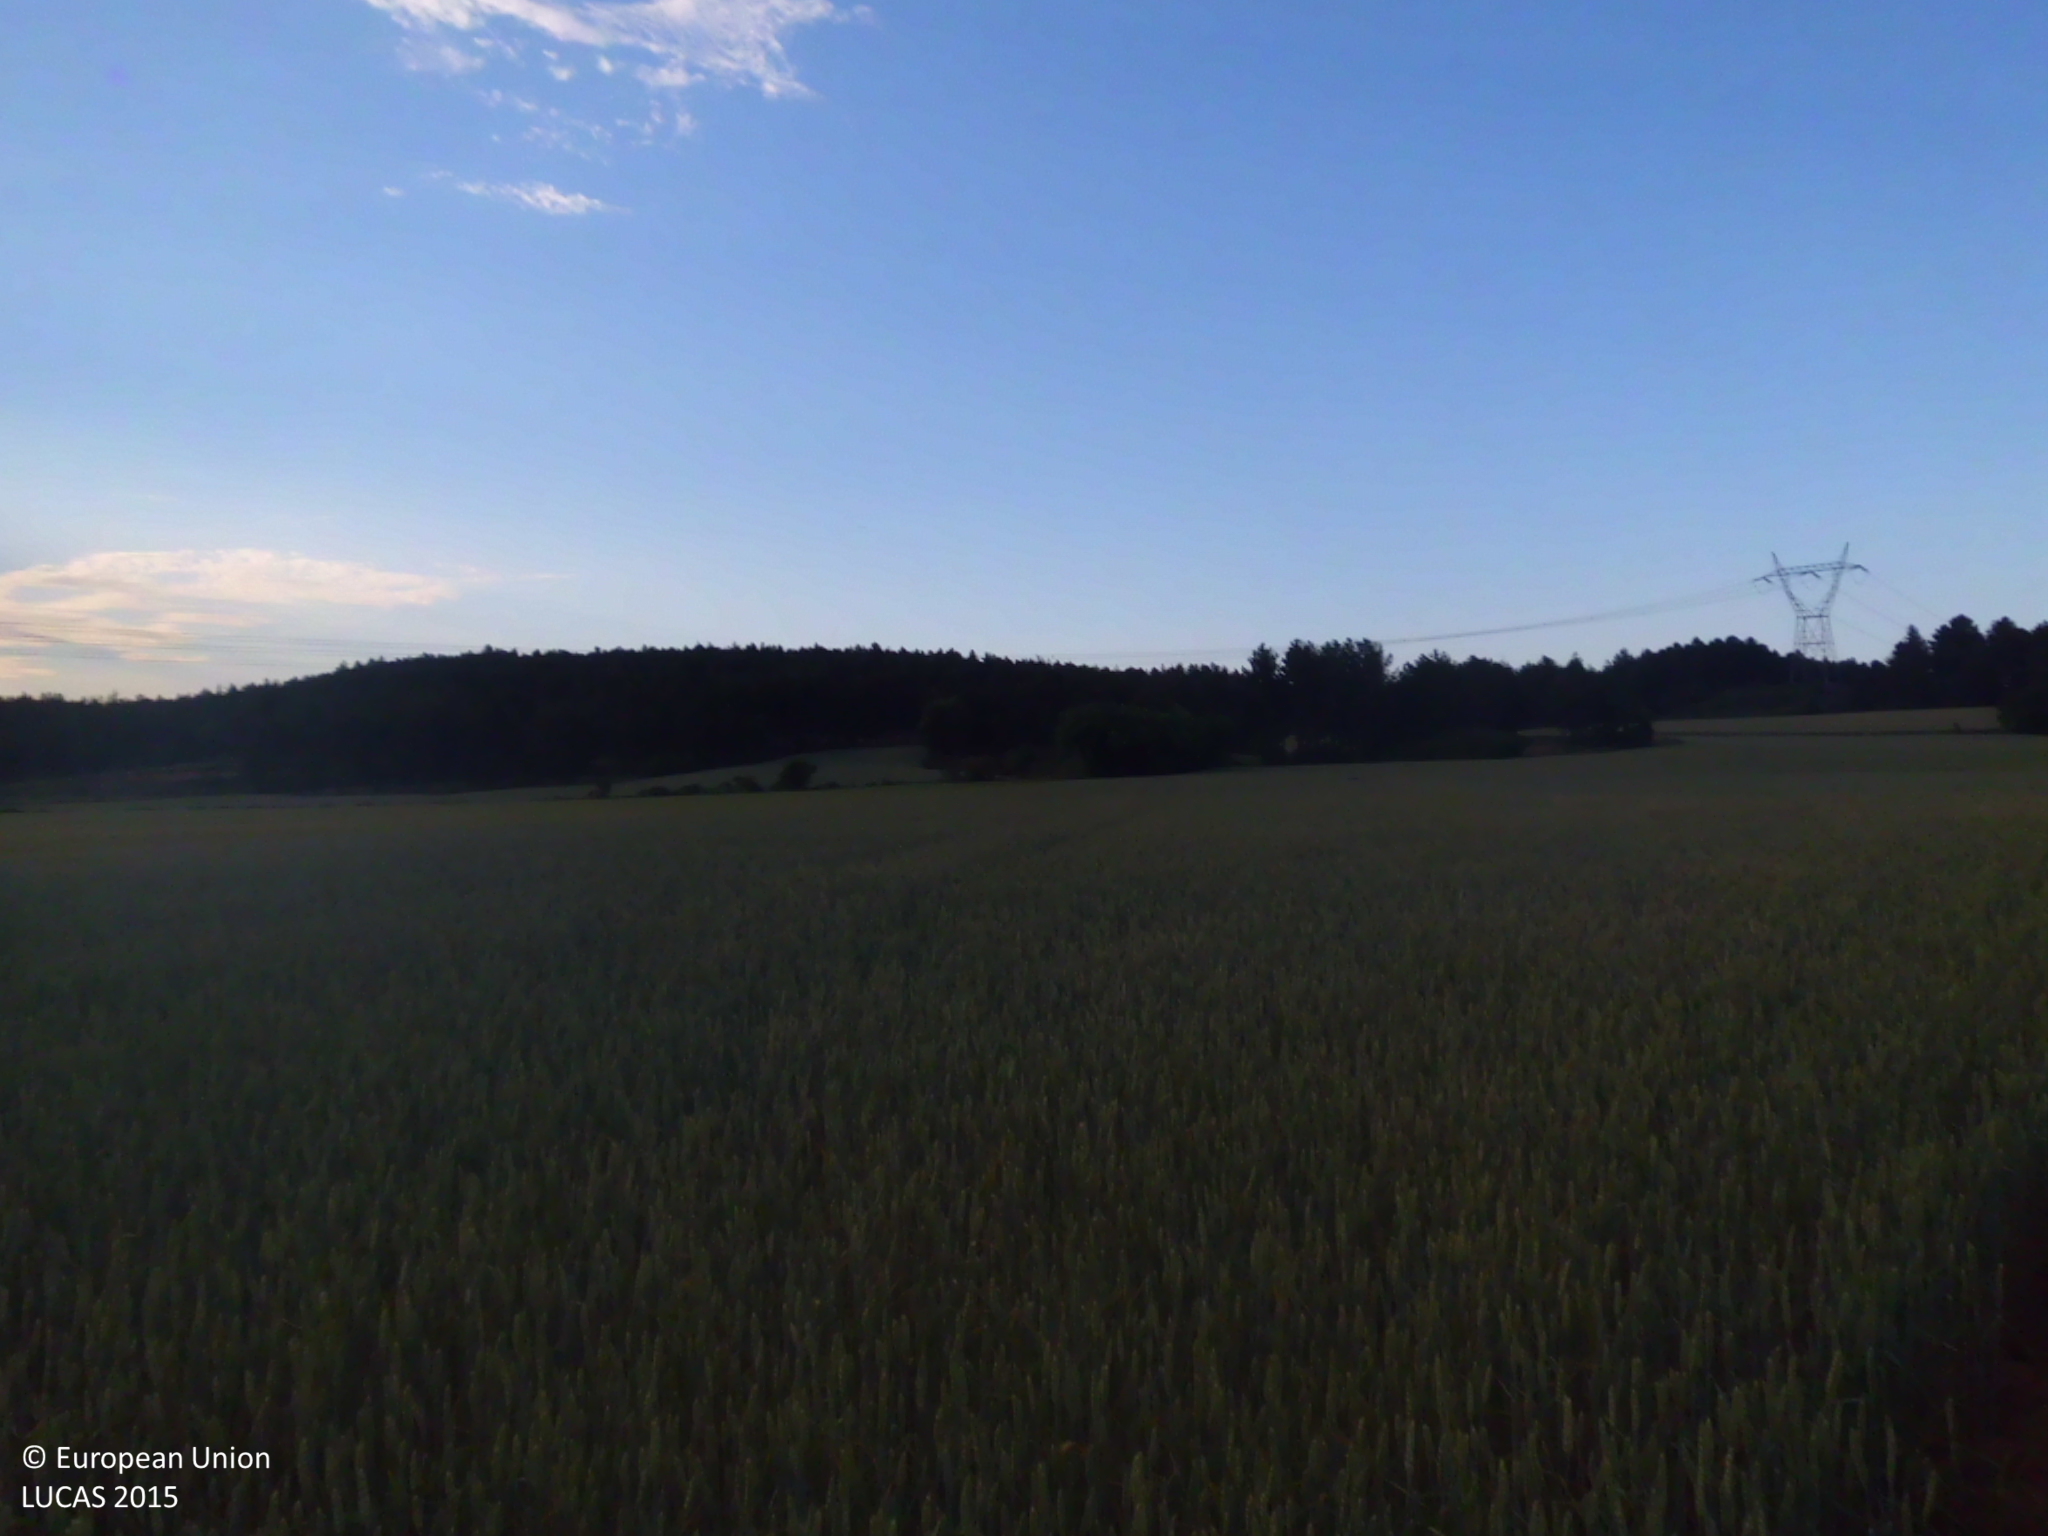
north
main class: Cropland
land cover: Common wheat
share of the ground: > 75 %
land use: Agriculture (excluding fallow land and kitchen gardens)
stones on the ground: < 10 %
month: June
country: ES
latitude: 42.5517
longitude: -4.4085
